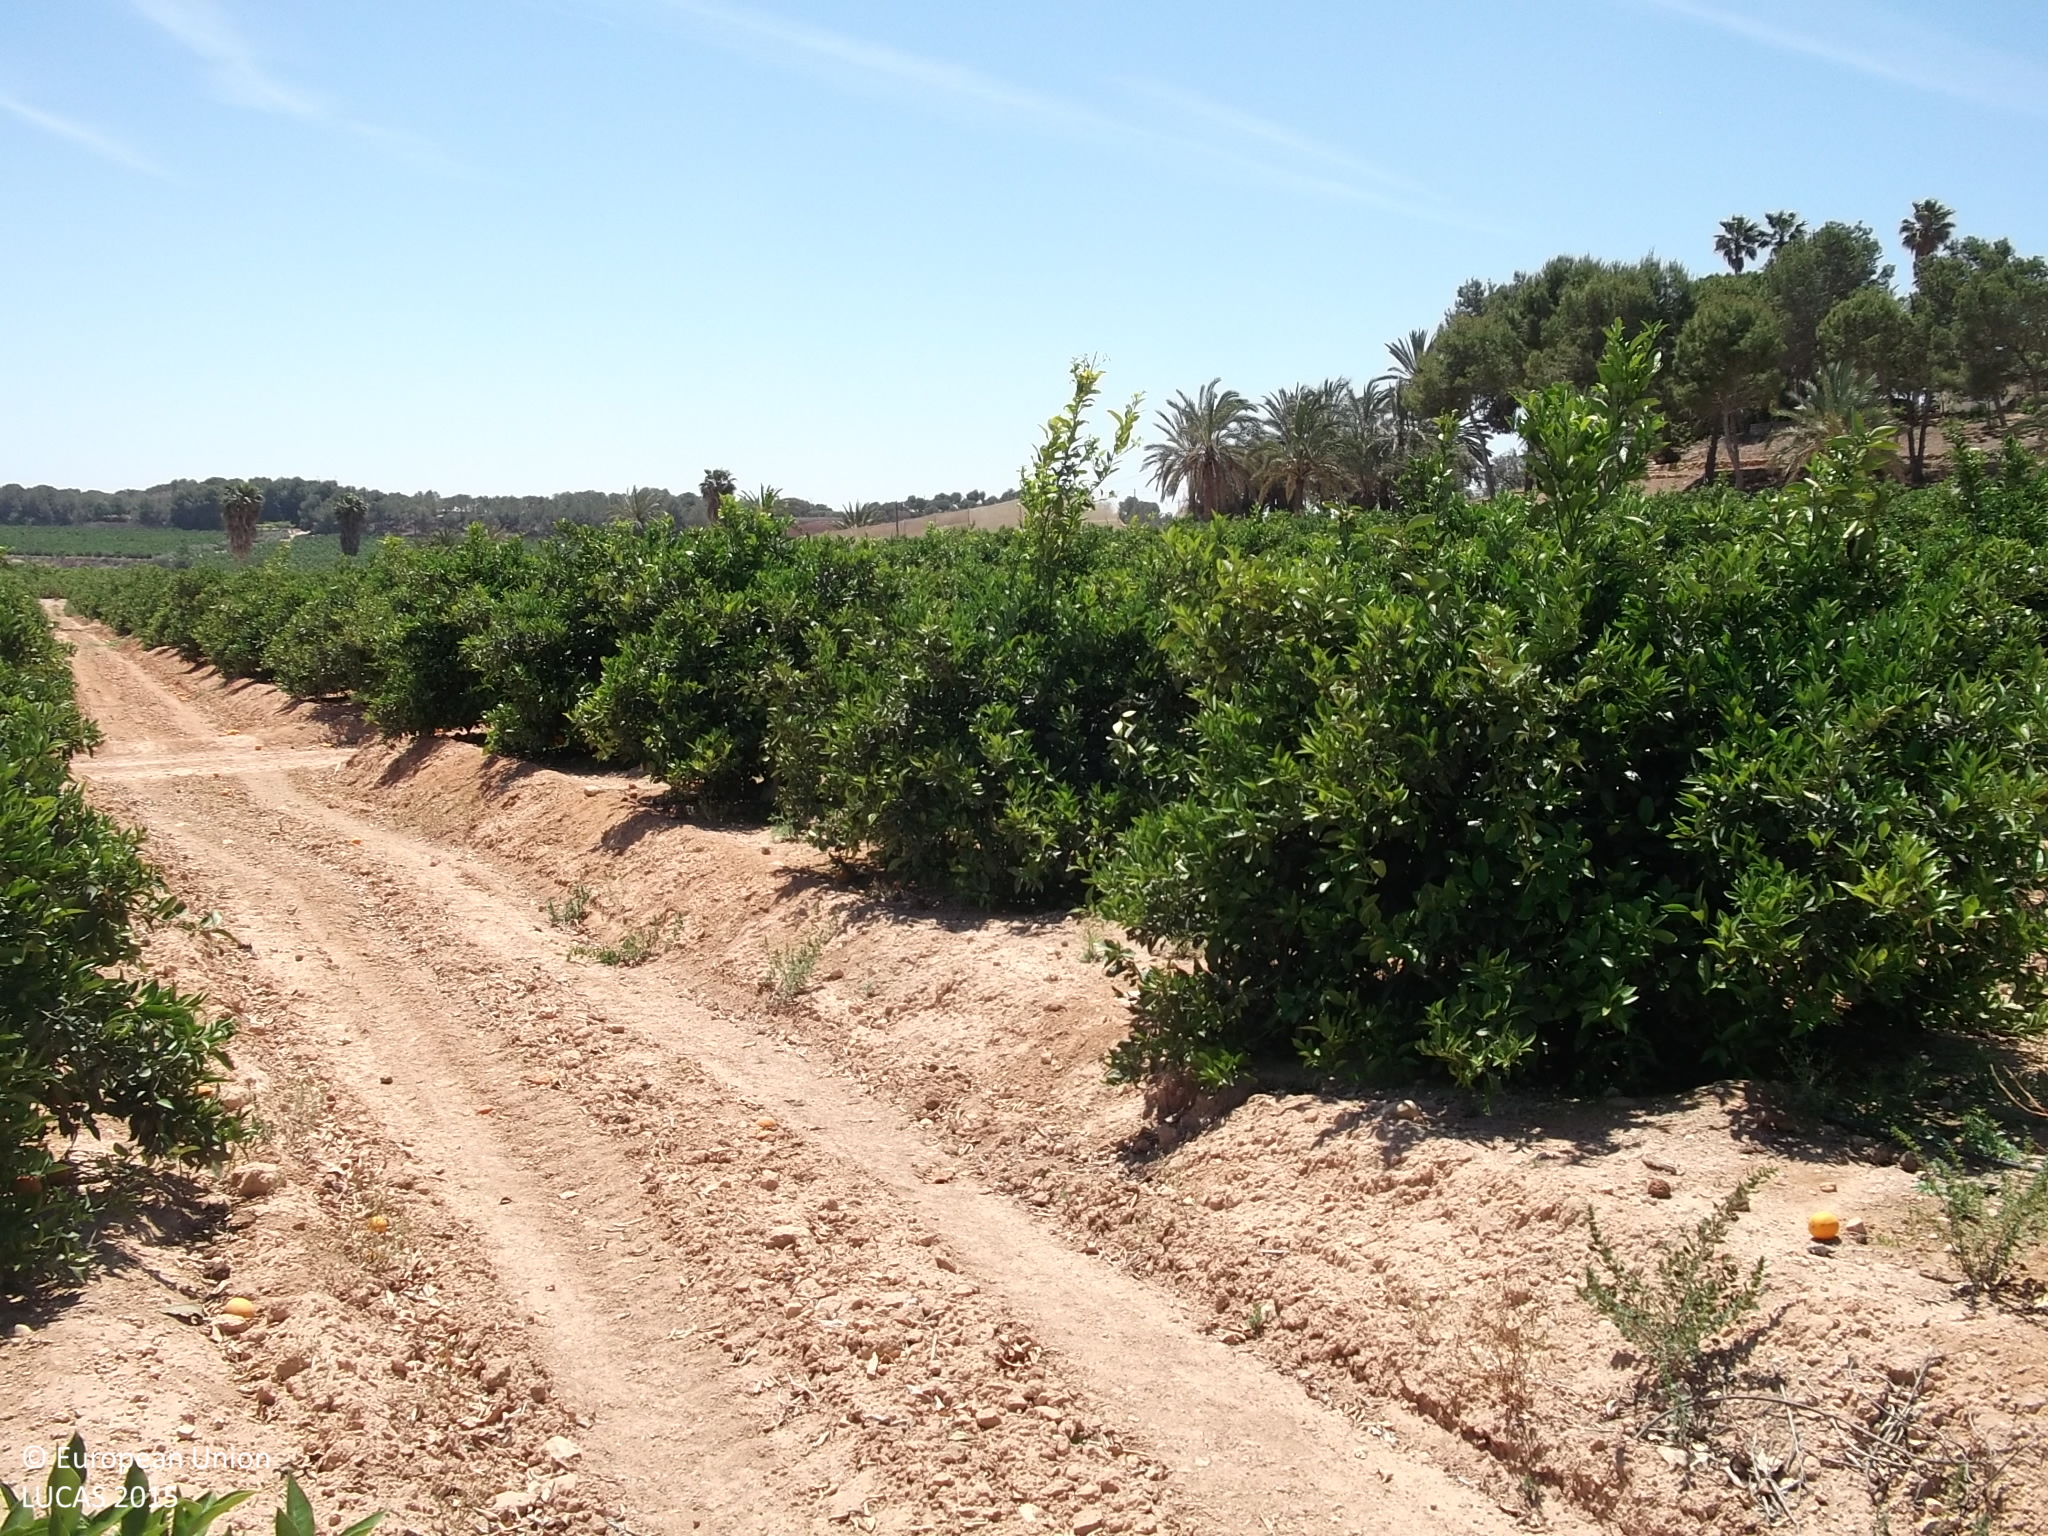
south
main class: Cropland
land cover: Oranges
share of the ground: 10 - 25 %
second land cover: Other bare soil
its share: > 75 %
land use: Agriculture (excluding fallow land and kitchen gardens)
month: May
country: ES
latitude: 37.8962
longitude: -0.8189
